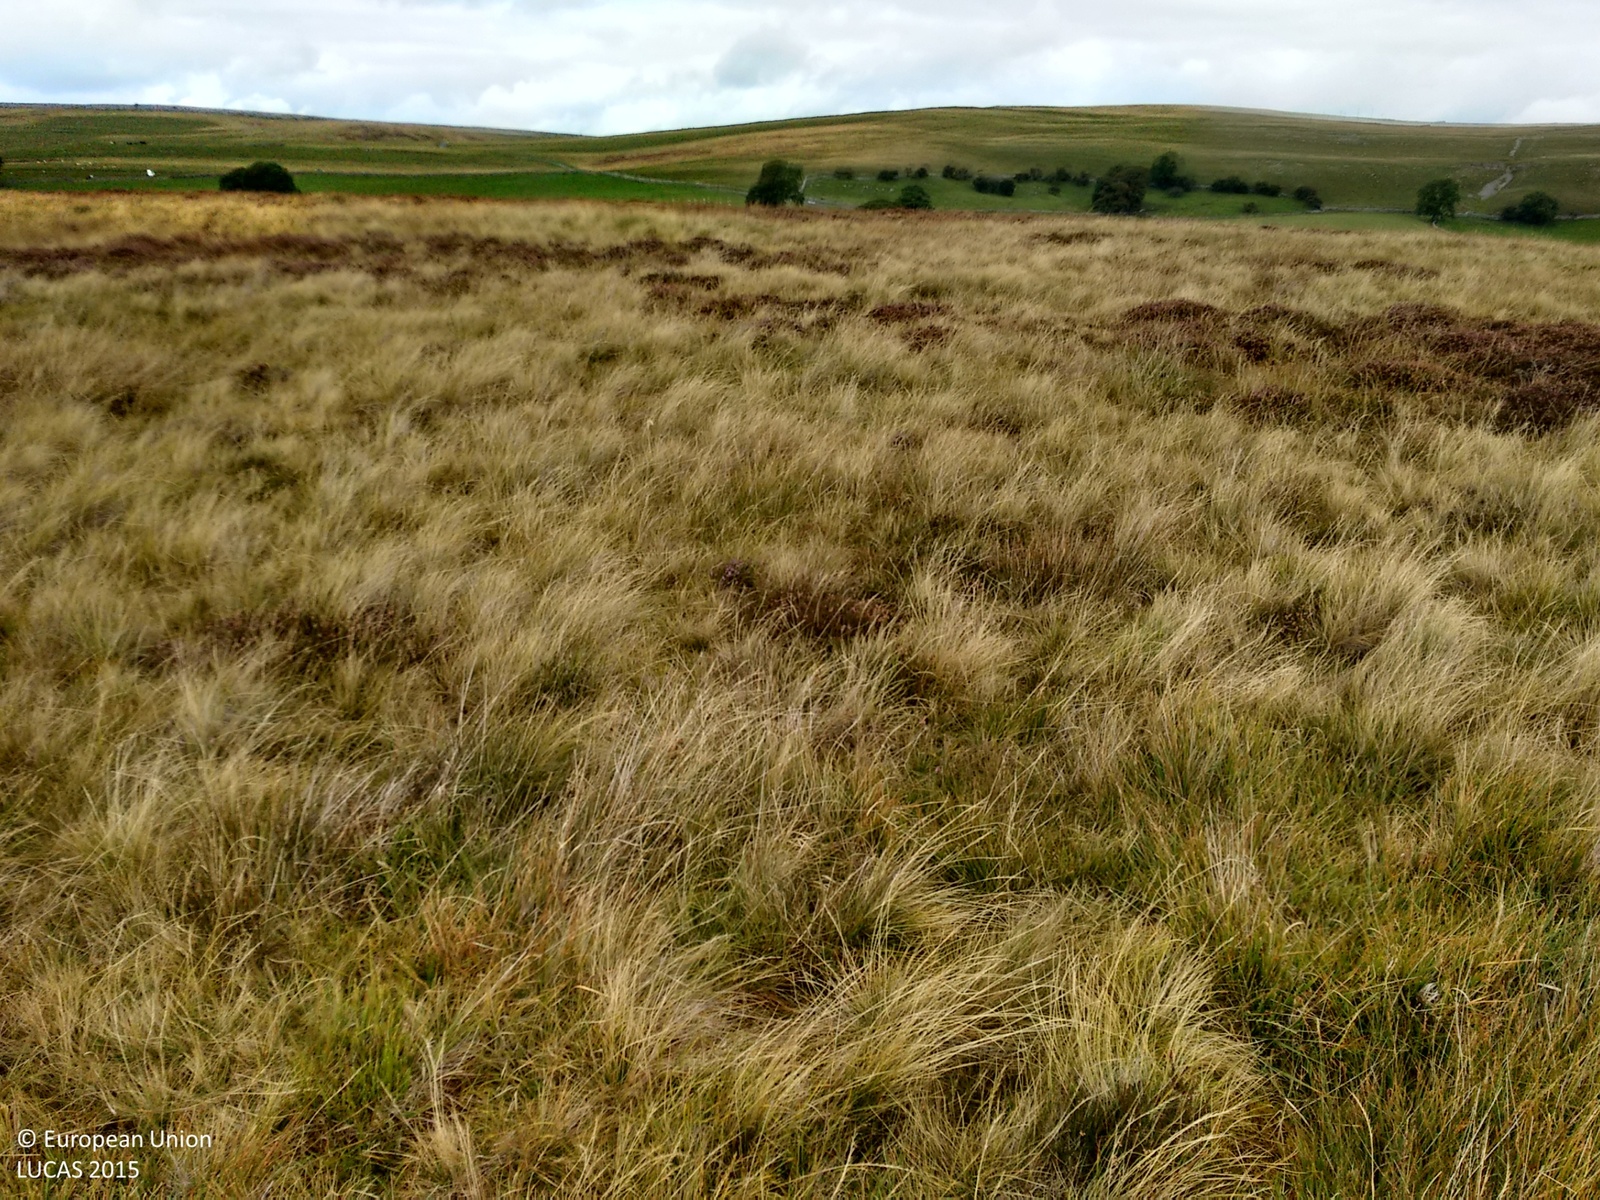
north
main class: Grassland
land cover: Grassland without tree/shrub cover
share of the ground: > 75 %
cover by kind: herbaceous plants 100 %
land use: Agriculture (excluding fallow land and kitchen gardens)
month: September
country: GB
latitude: 54.4642
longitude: -2.4830
